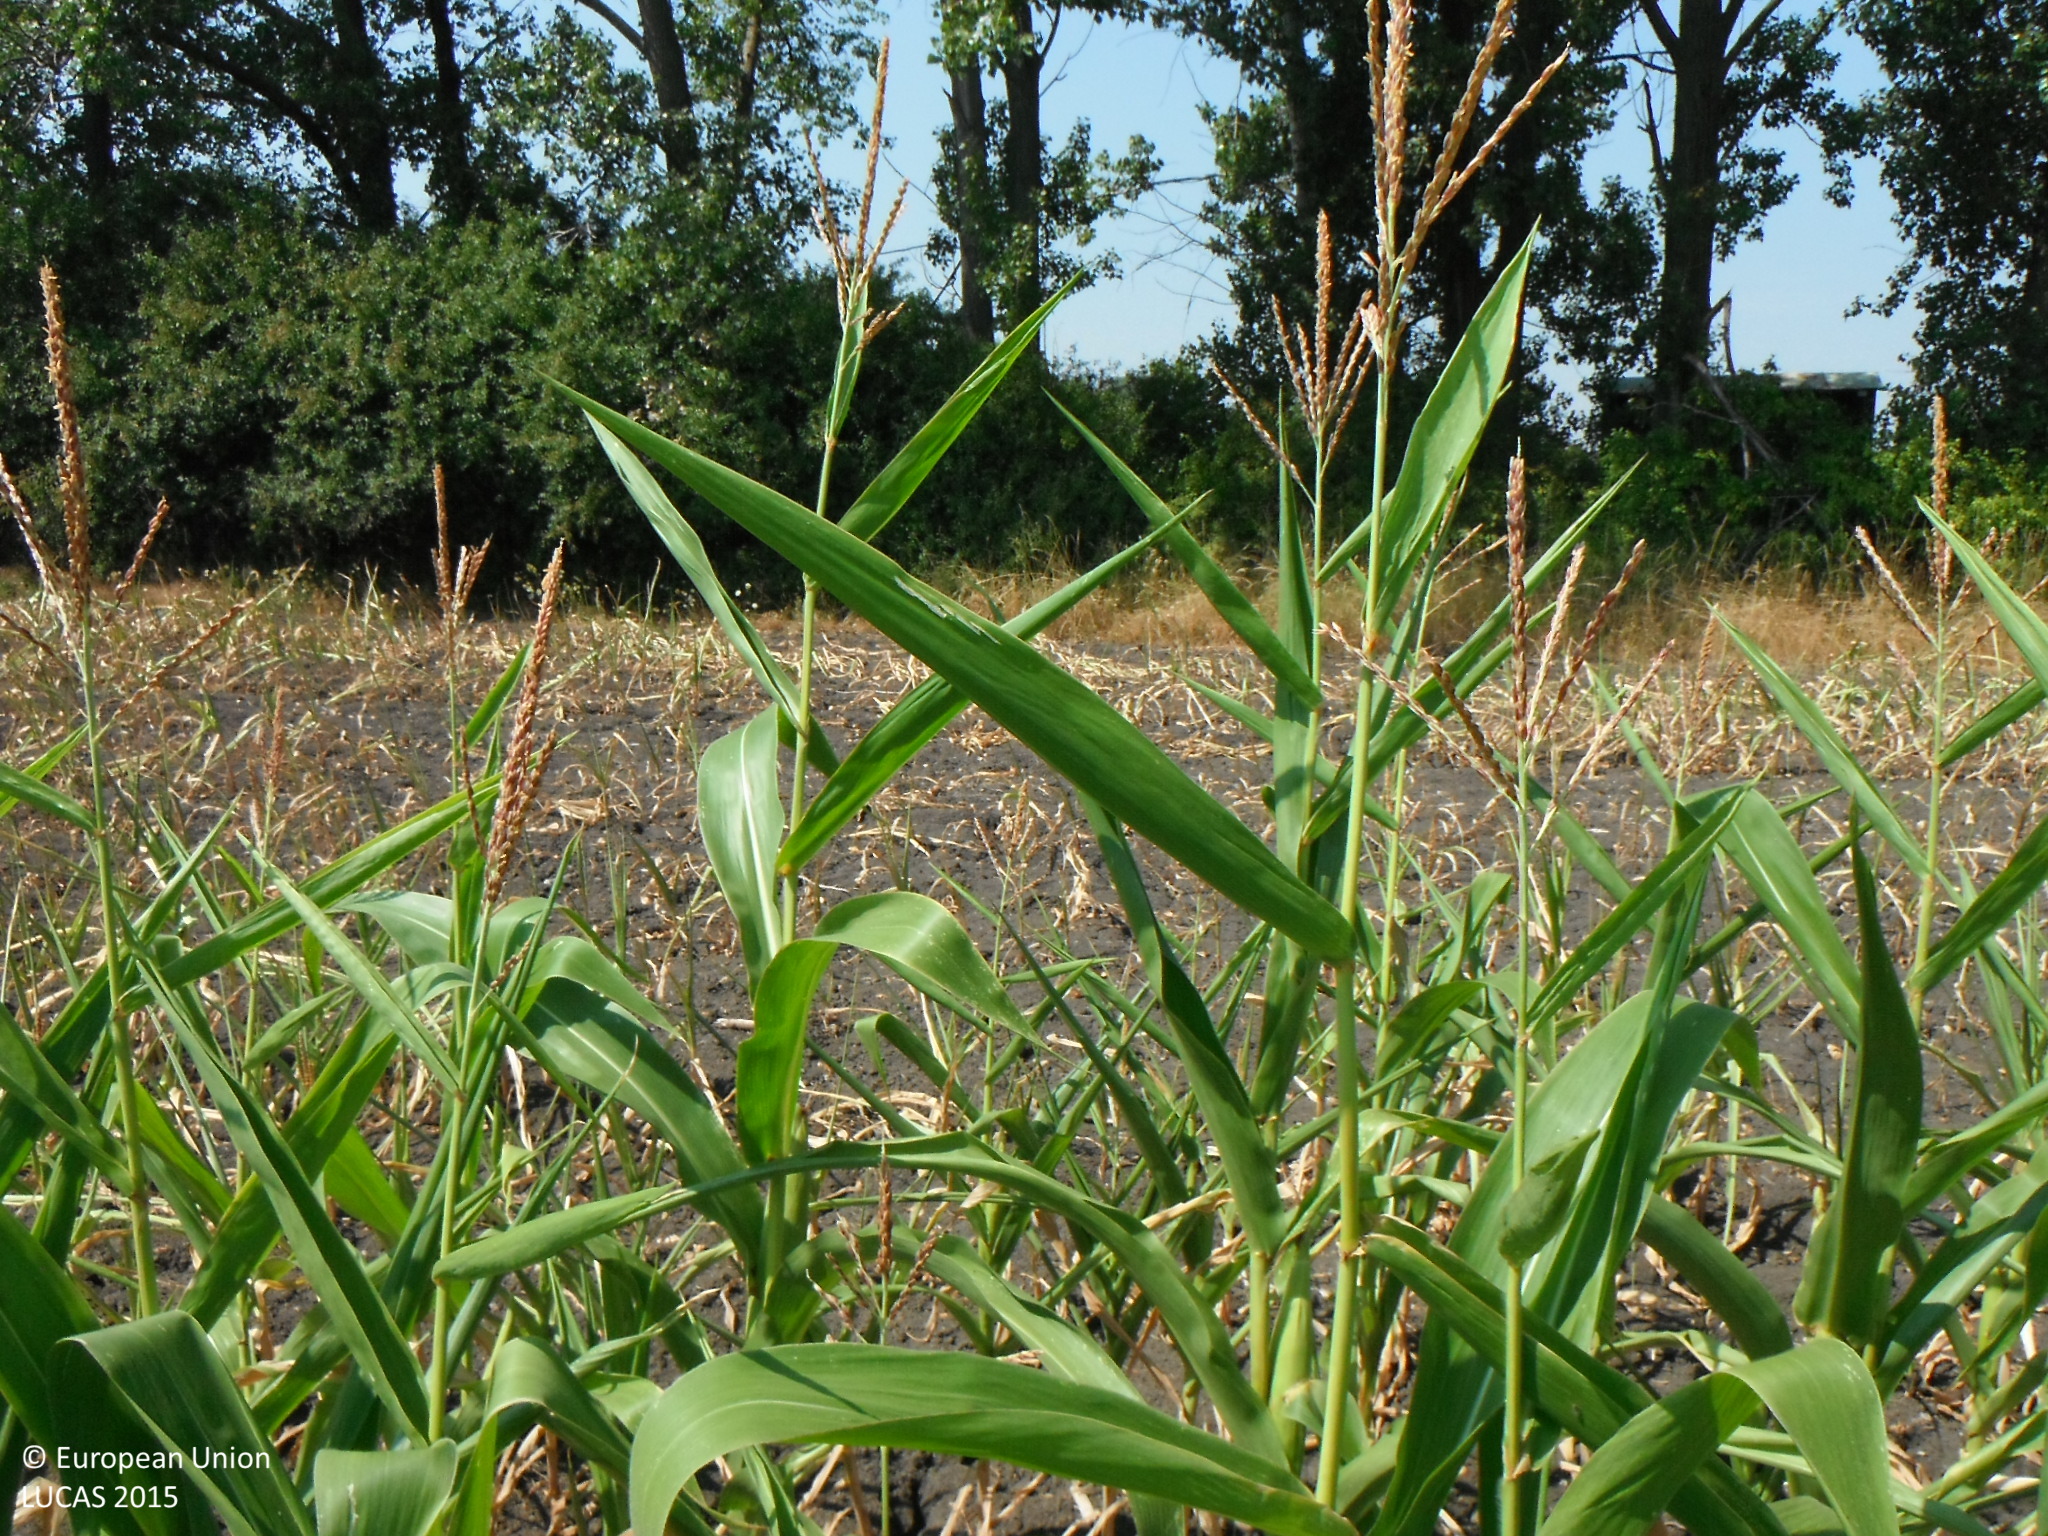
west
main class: Cropland
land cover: Maize
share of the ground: > 75 %
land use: Agriculture (excluding fallow land and kitchen gardens)
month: August
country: SK
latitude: 48.0773
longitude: 18.2421
